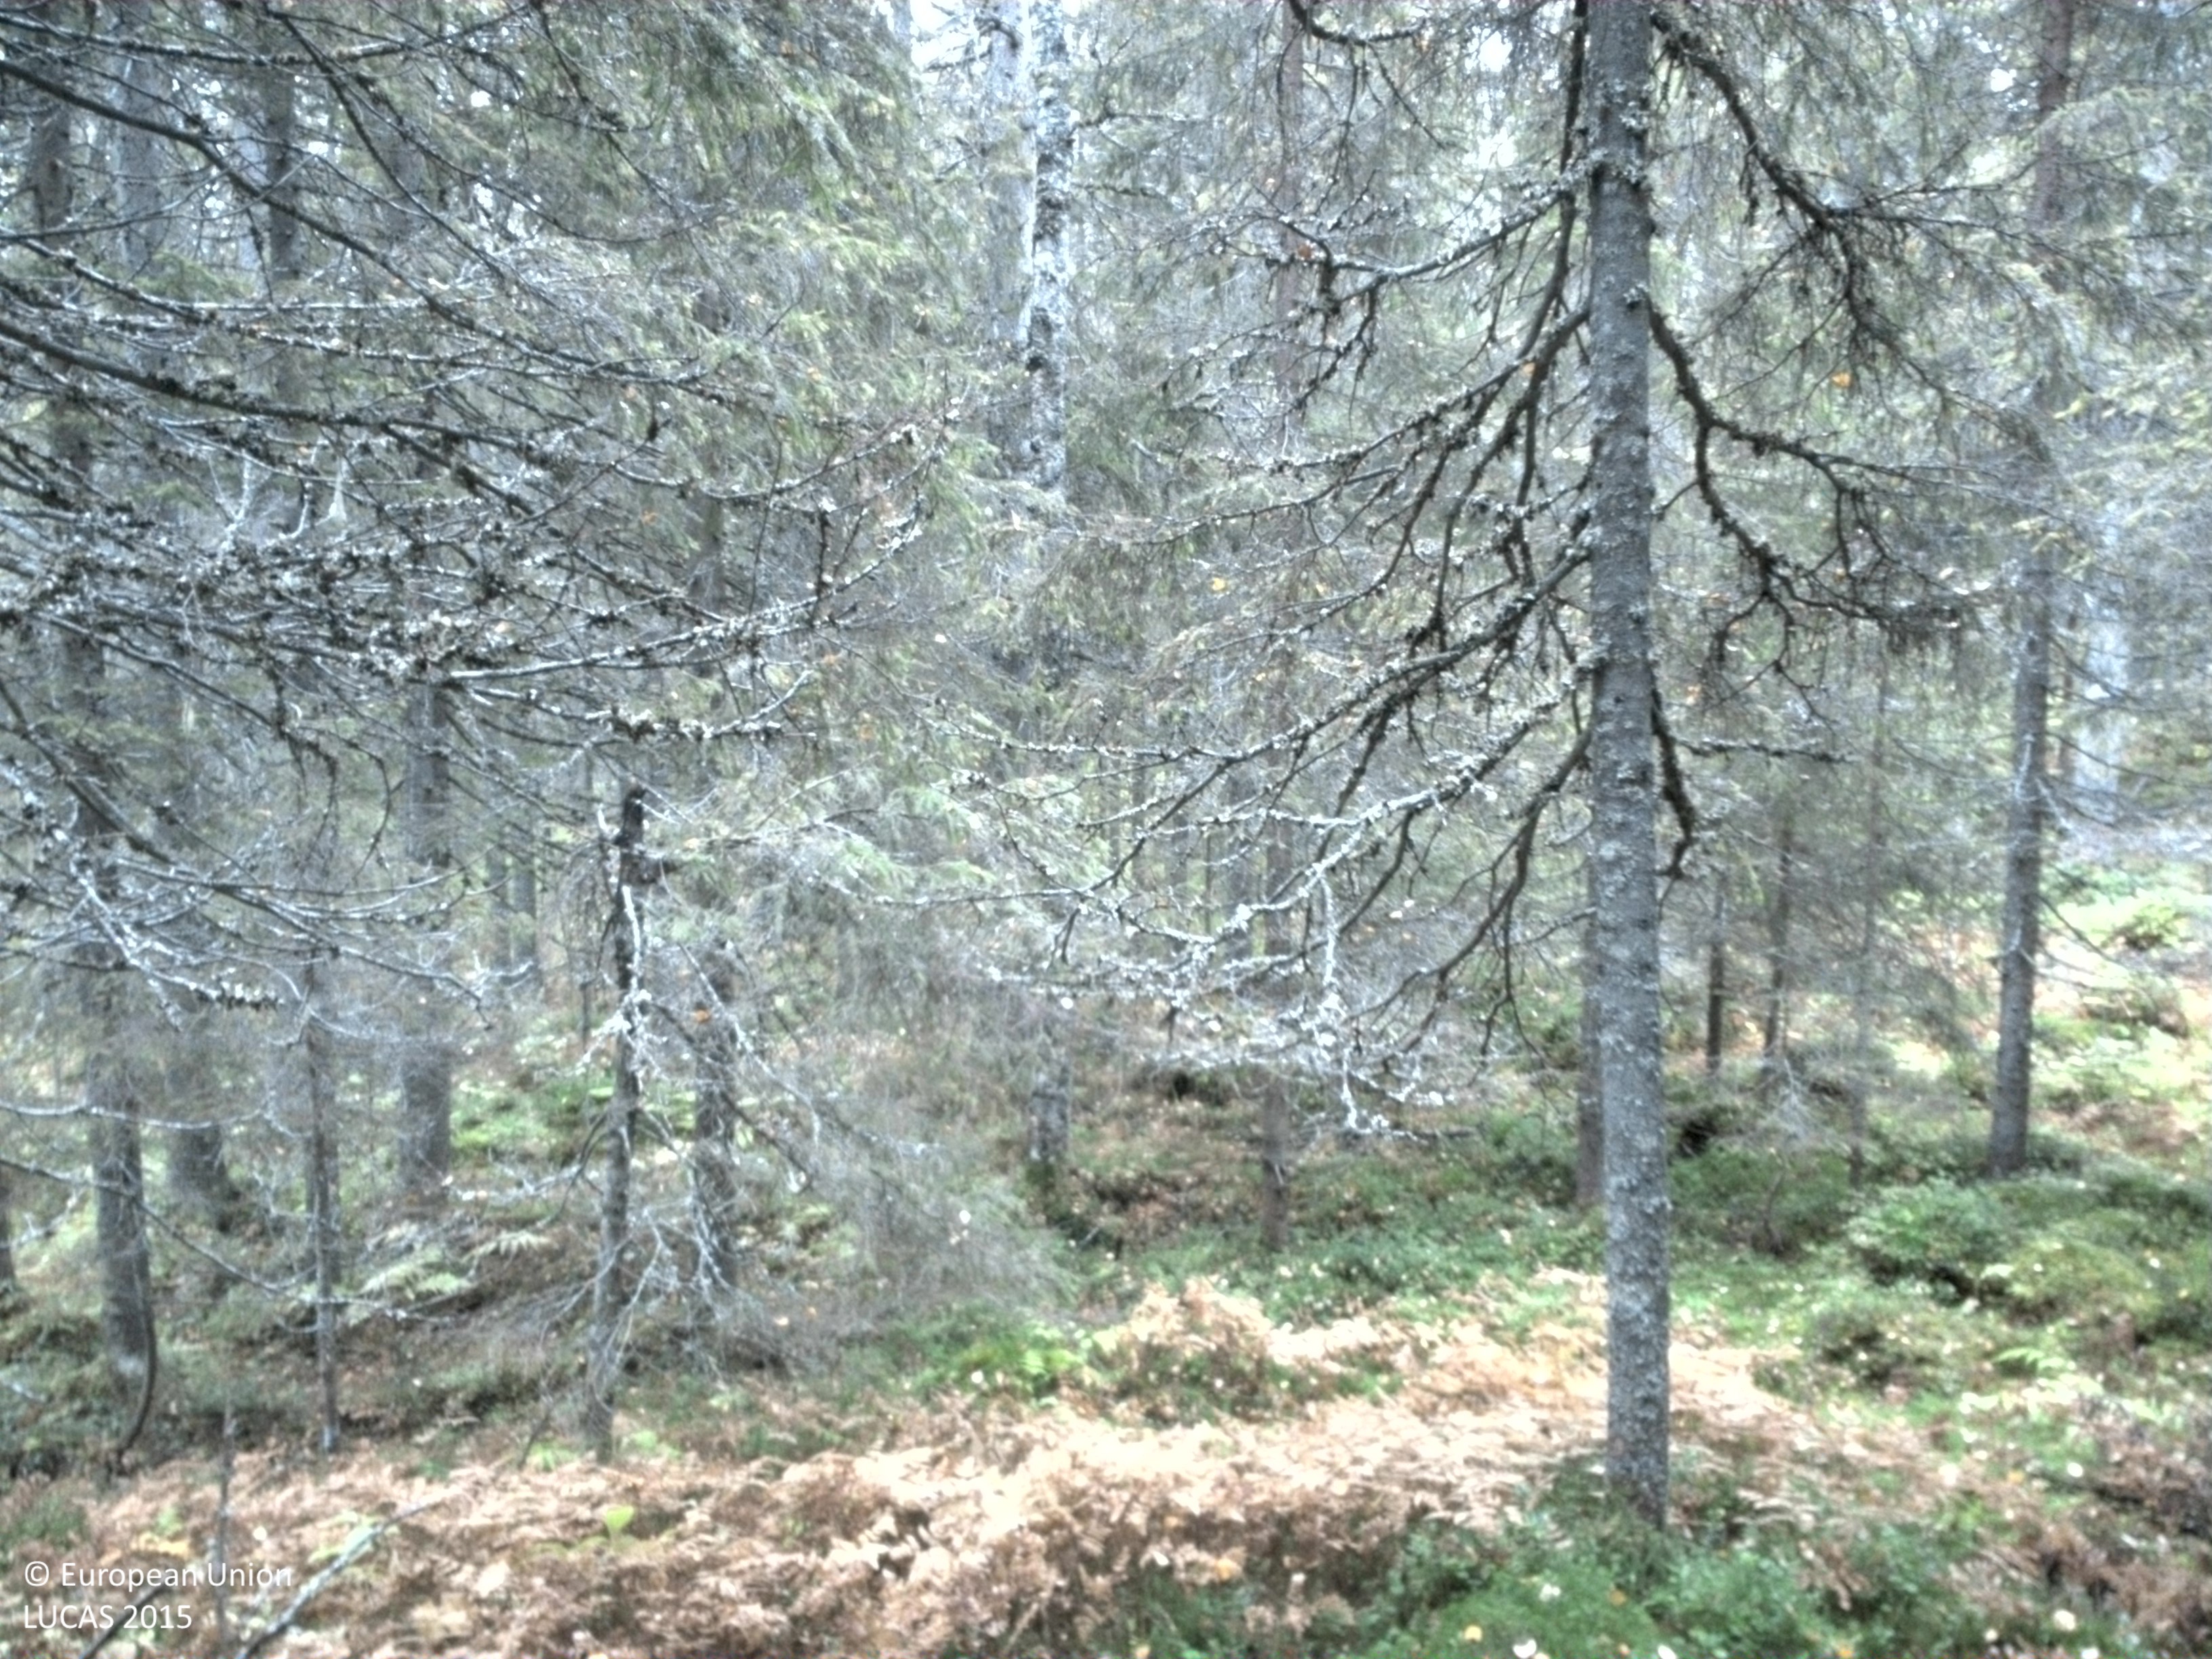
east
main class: Woodland
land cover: Spruce dominated coniferous woodland
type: boreal forest
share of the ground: 50 - 75 %
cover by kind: coniferous forest trees 60 %, shrubs 15 %, herbaceous plants 15 %, lichens and mosses 10 %
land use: Forestry
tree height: > 5 m
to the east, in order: Spruce dominated coniferous woodland
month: September
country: SE
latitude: 64.8784
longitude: 17.7966
